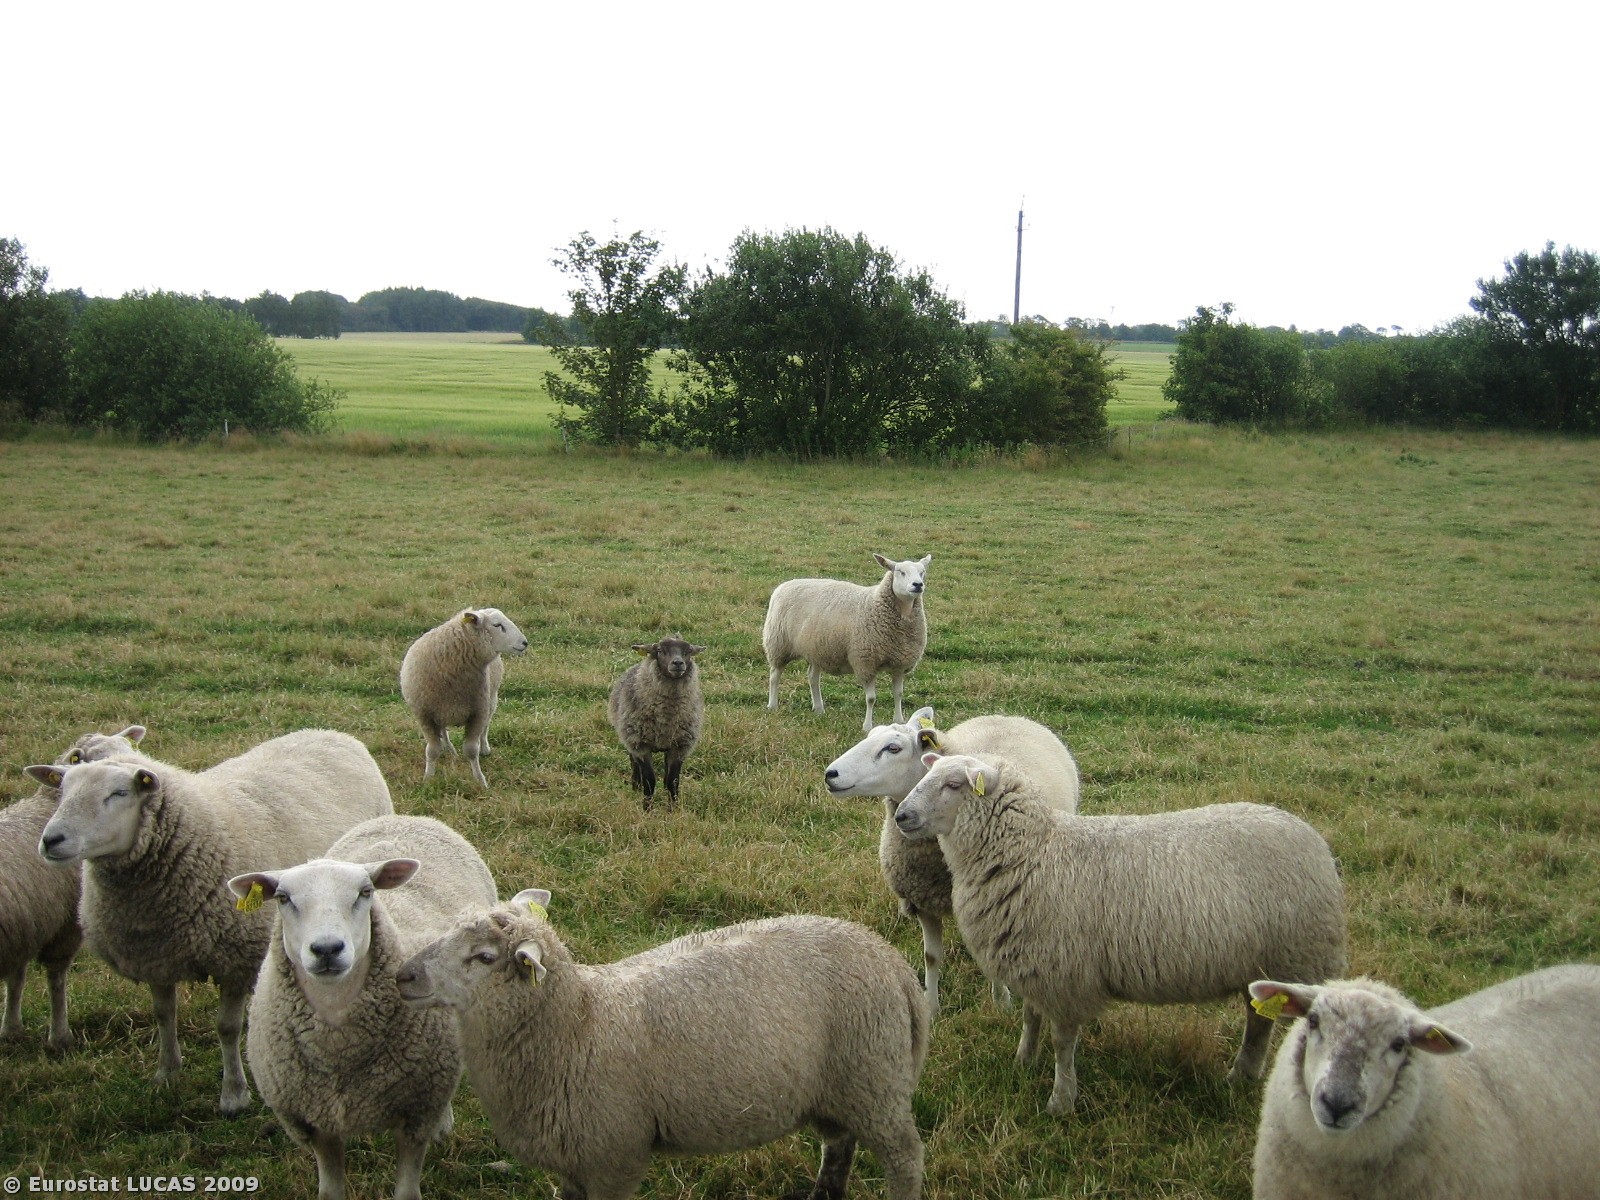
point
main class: Grassland
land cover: Grassland without tree/shrub cover
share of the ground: > 75 %
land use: Agriculture (excluding fallow land and kitchen gardens)
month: July
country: DK
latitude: 55.7638
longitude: 8.3600
